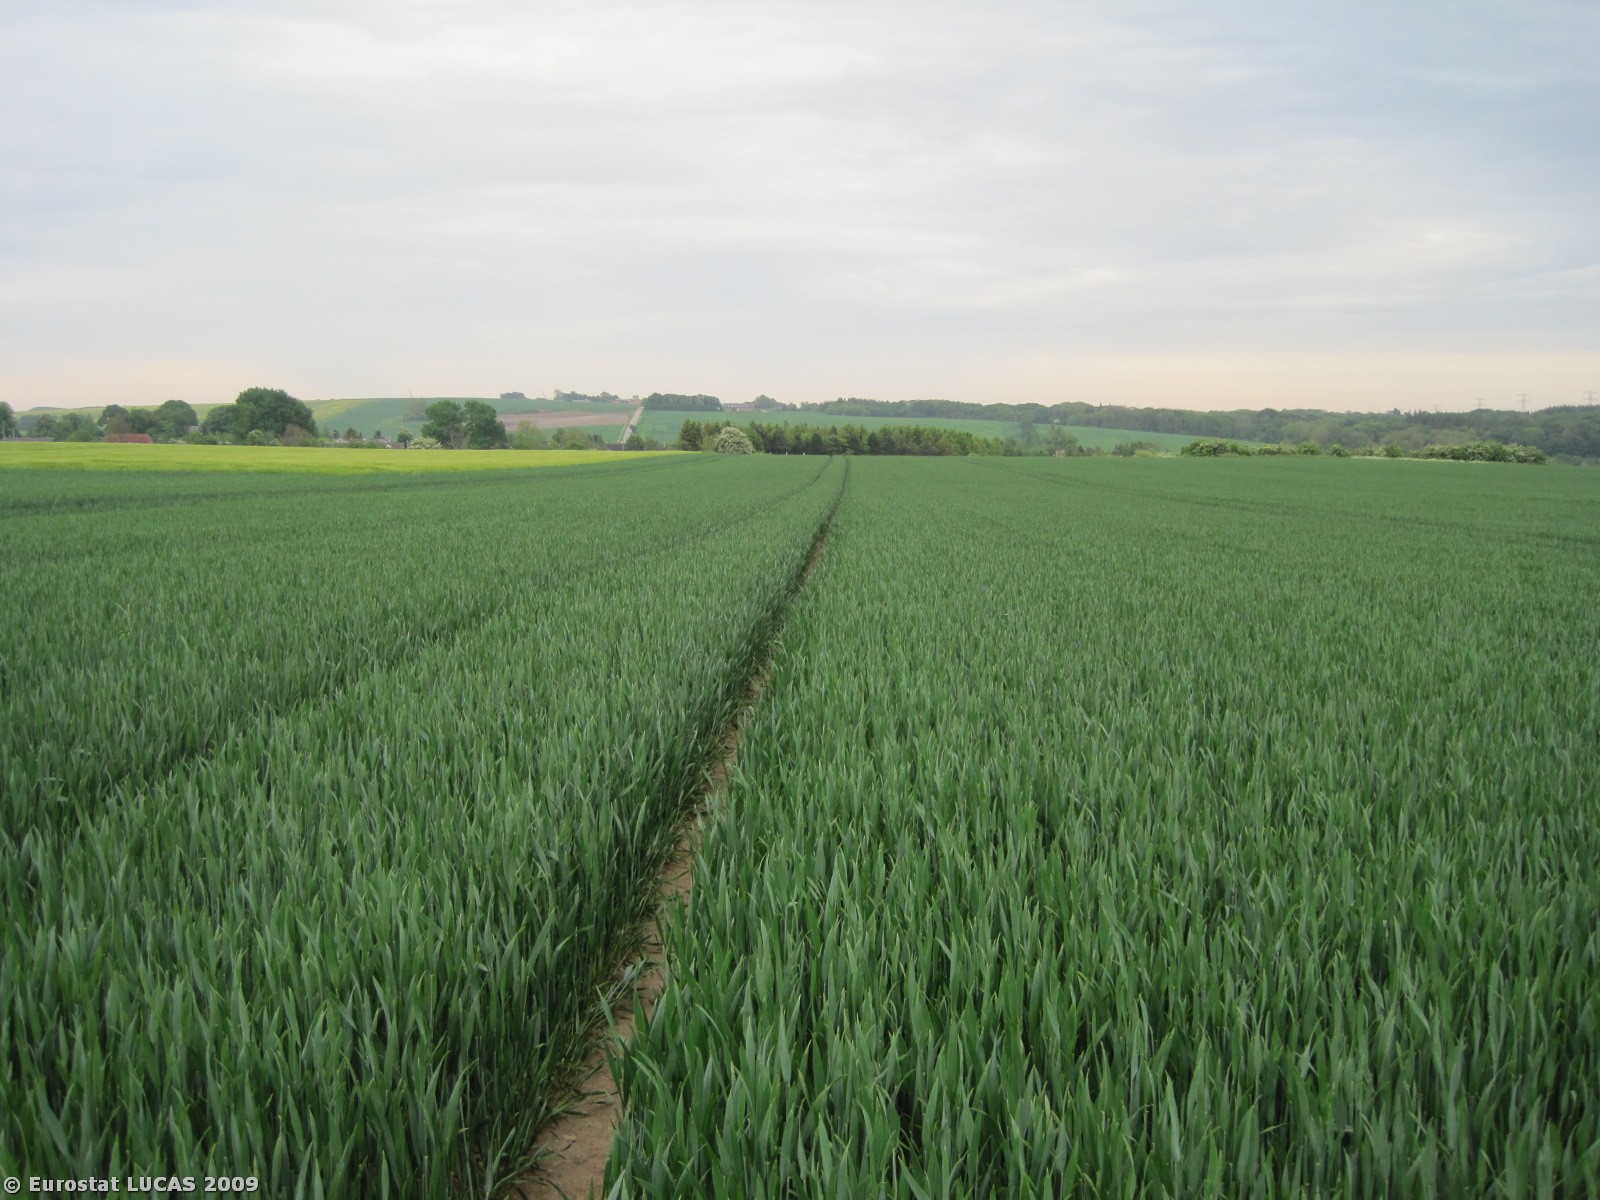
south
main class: Cropland
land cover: Common wheat
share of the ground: > 75 %
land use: Agriculture (excluding fallow land and kitchen gardens)
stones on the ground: 10 - 25 %
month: May
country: DK
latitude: 56.4214
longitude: 10.0162
